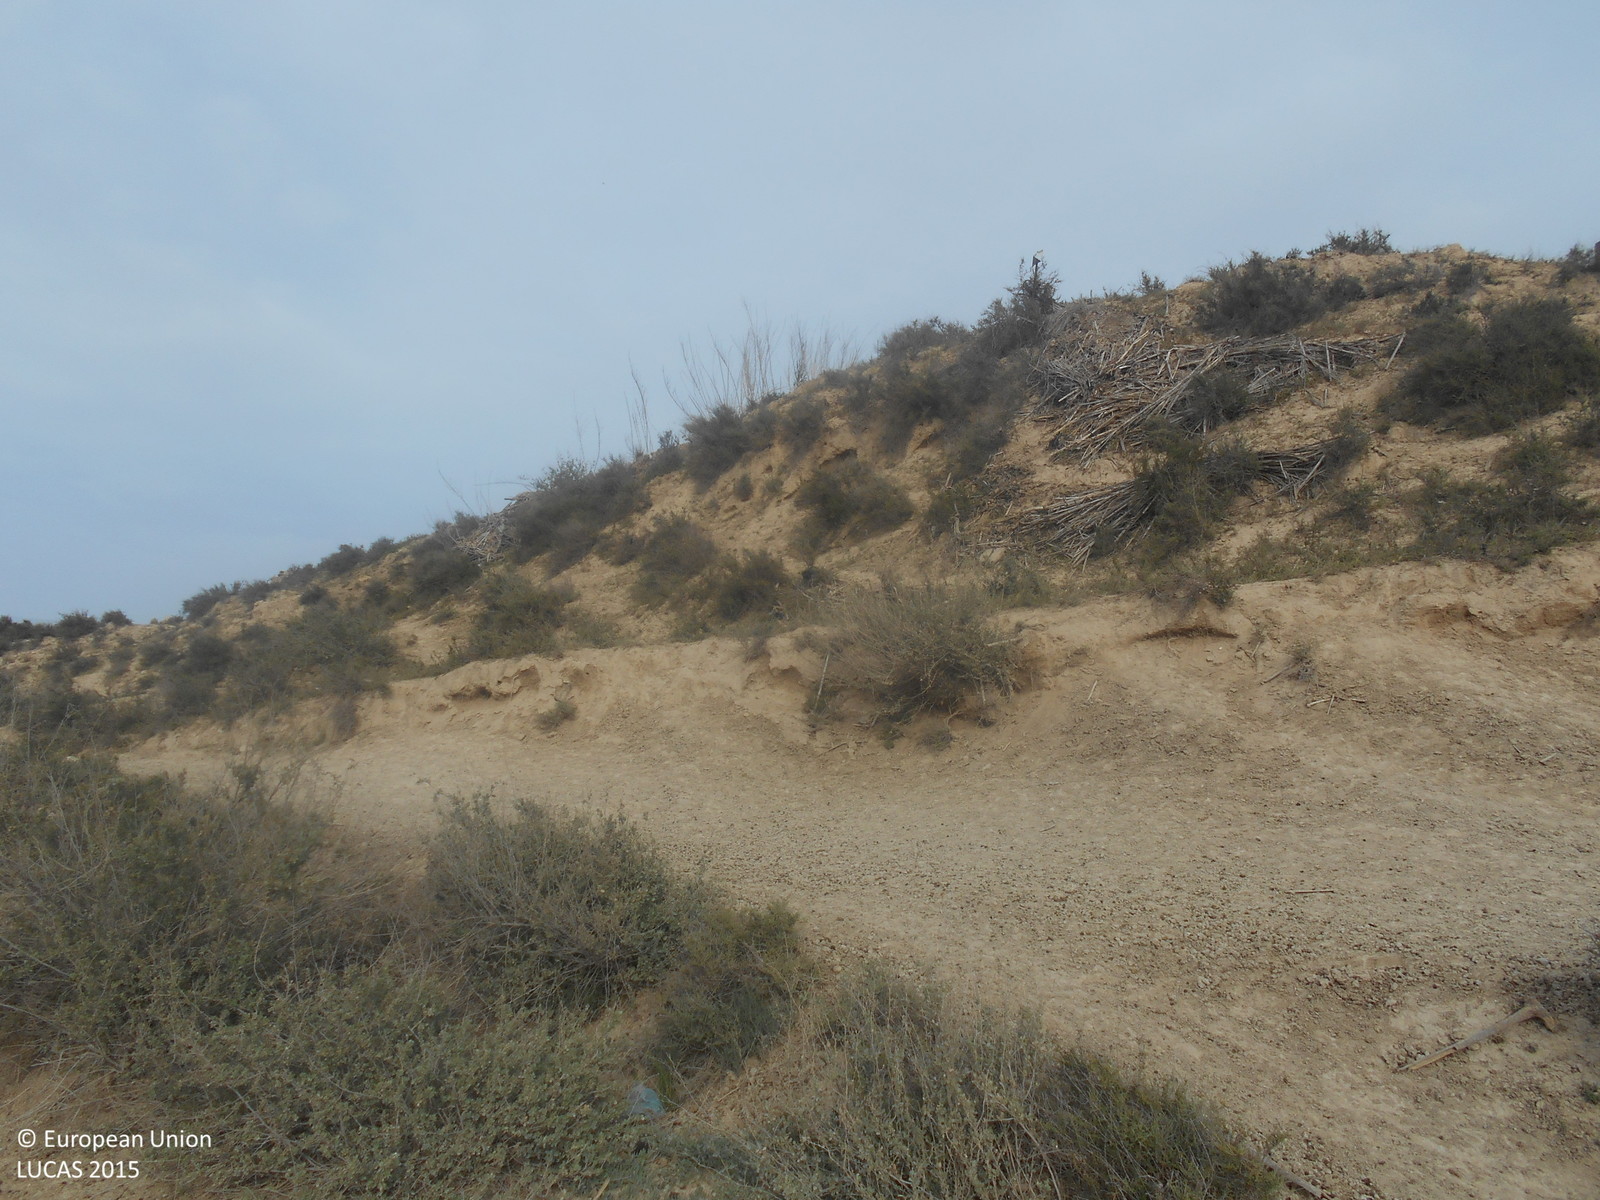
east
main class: Shrubland
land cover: Shrubland without tree cover
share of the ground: 25 - 50 %
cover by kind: shrubs 40 %, unconsolidated bare surface 40 %, herbaceous plants 20 %
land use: Semi-natural and natural areas not in use
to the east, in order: Shrubland without tree cover; Tracks; Shrubland without tree cover; Tracks; Shrubland without tree cover; Tracks; Shrubland without tree cover; Grassland without tree/shrub cover; Paved roads, cycling and walking lanes; Grass margins; Ditches and canals; Grassland without tree/shrub cover; Ditches and canals; Grass margins; Tracks; Other fresh vegetables; Tracks; Ditches and canals; Grass margins
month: April
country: ES
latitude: 37.7535
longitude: -1.4117
